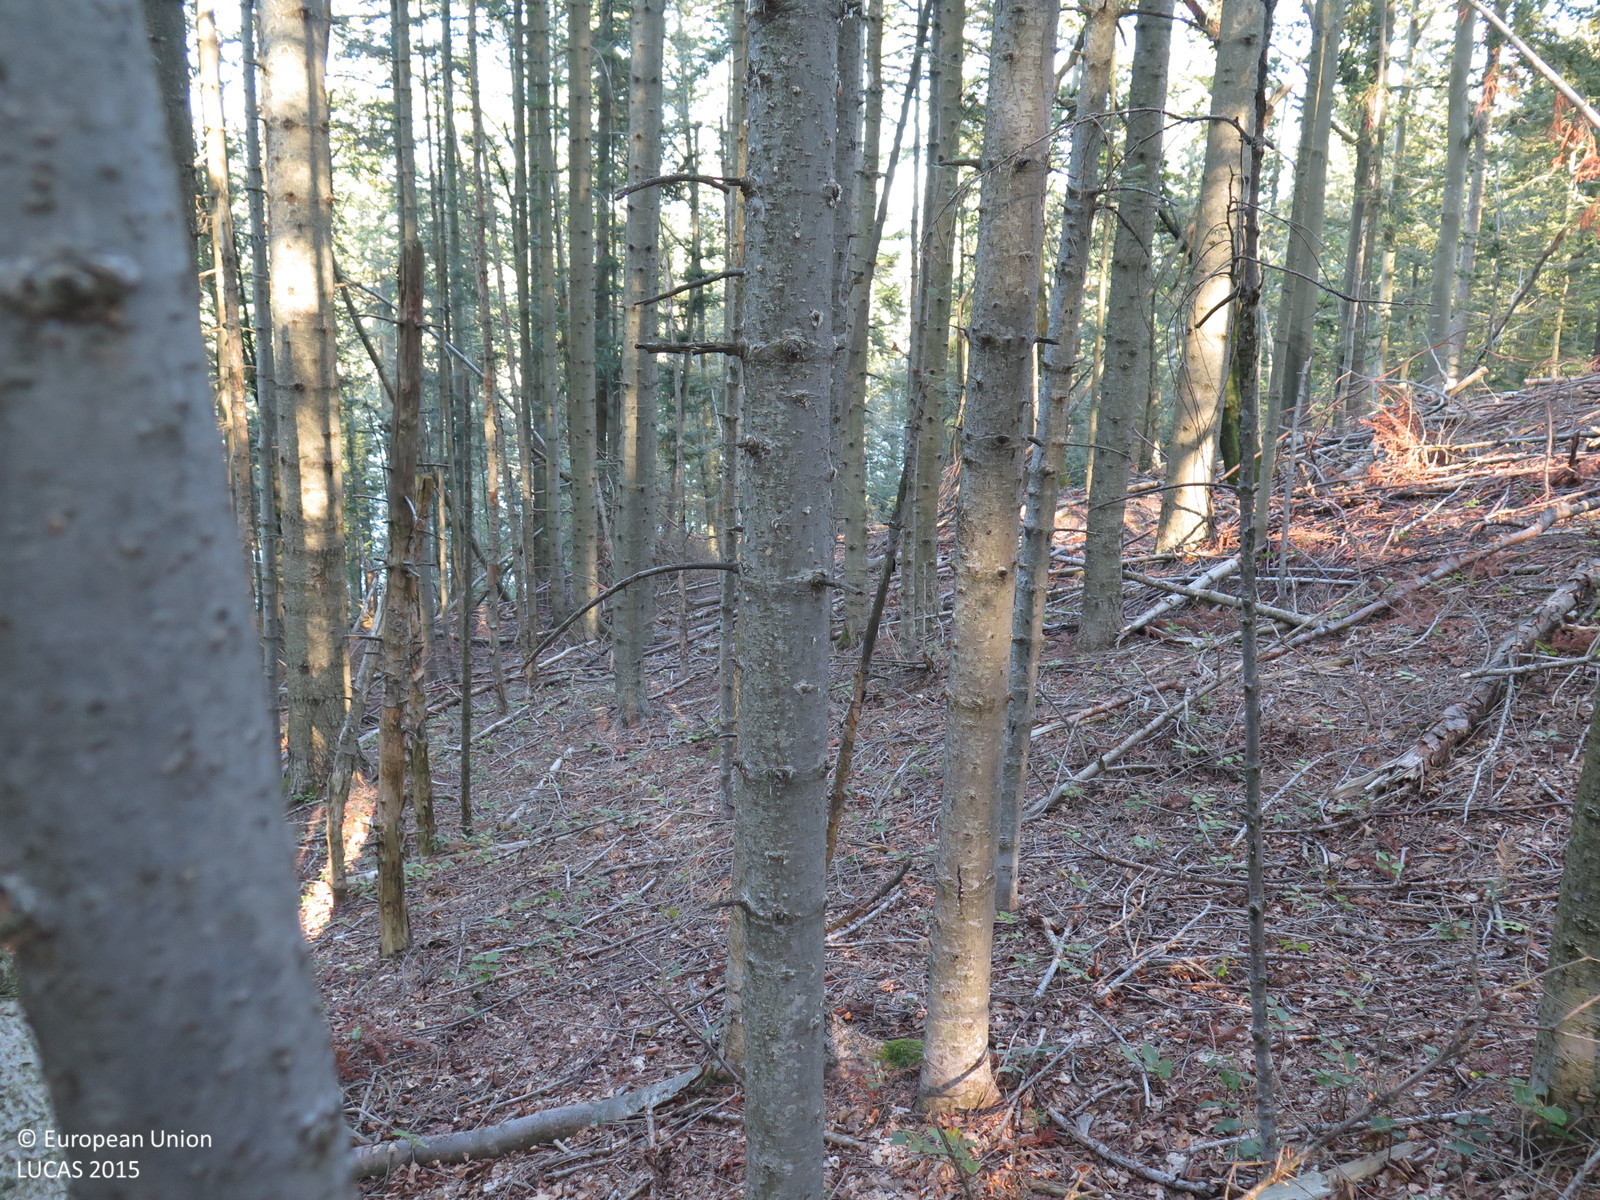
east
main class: Woodland
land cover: Other coniferous woodland
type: alpine coniferous forest
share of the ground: > 75 %
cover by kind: coniferous forest trees 90 %, herbaceous plants 5 %, unconsolidated bare surface 5 %
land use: Forestry
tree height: > 5 m
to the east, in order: Other coniferous woodland; Shrubland with sparse tree cover; Grass margins; Tracks; Grass margins; Other coniferous woodland; Sand; Inland fresh water bodies
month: August
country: HR
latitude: 45.3634
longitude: 14.7061
